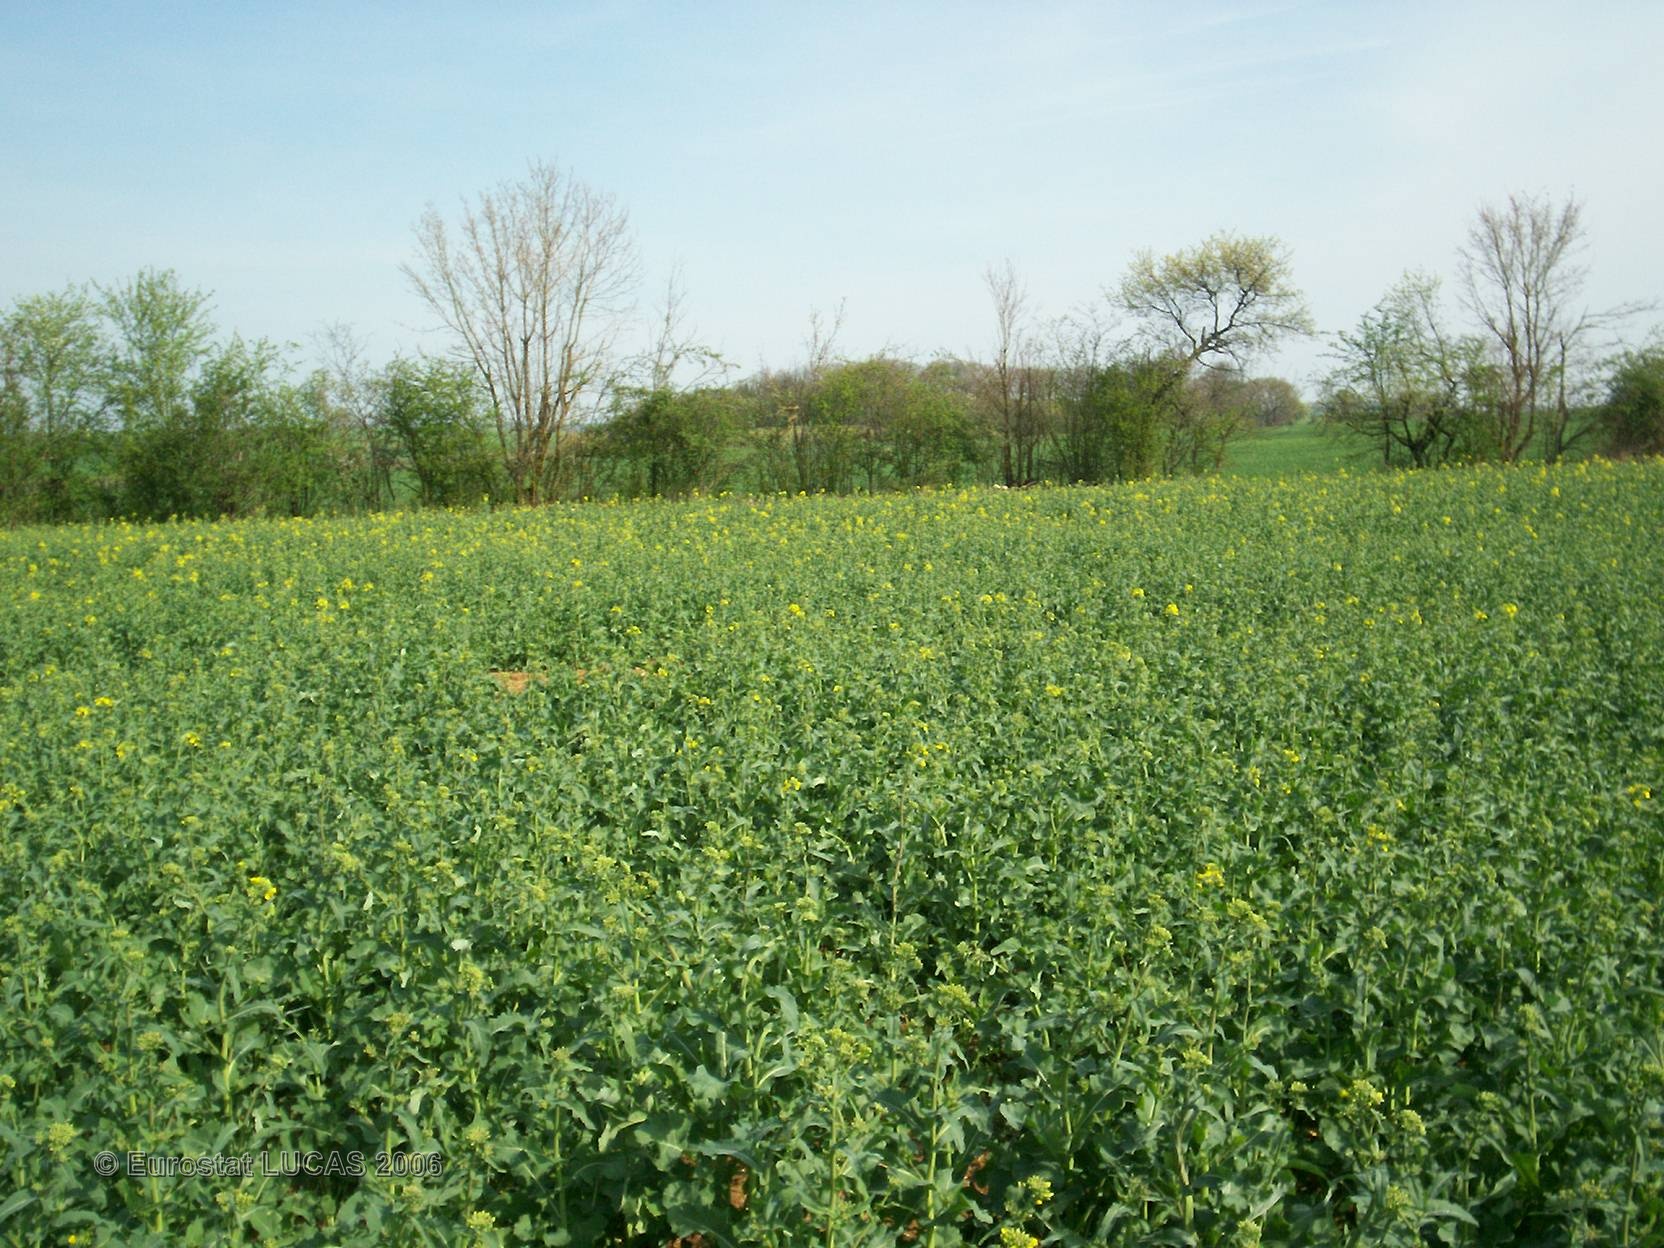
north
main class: Cropland
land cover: Rape and turnip rape
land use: Agriculture (excluding fallow land and kitchen gardens)
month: May
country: FR
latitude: 47.6035
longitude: 4.5854
